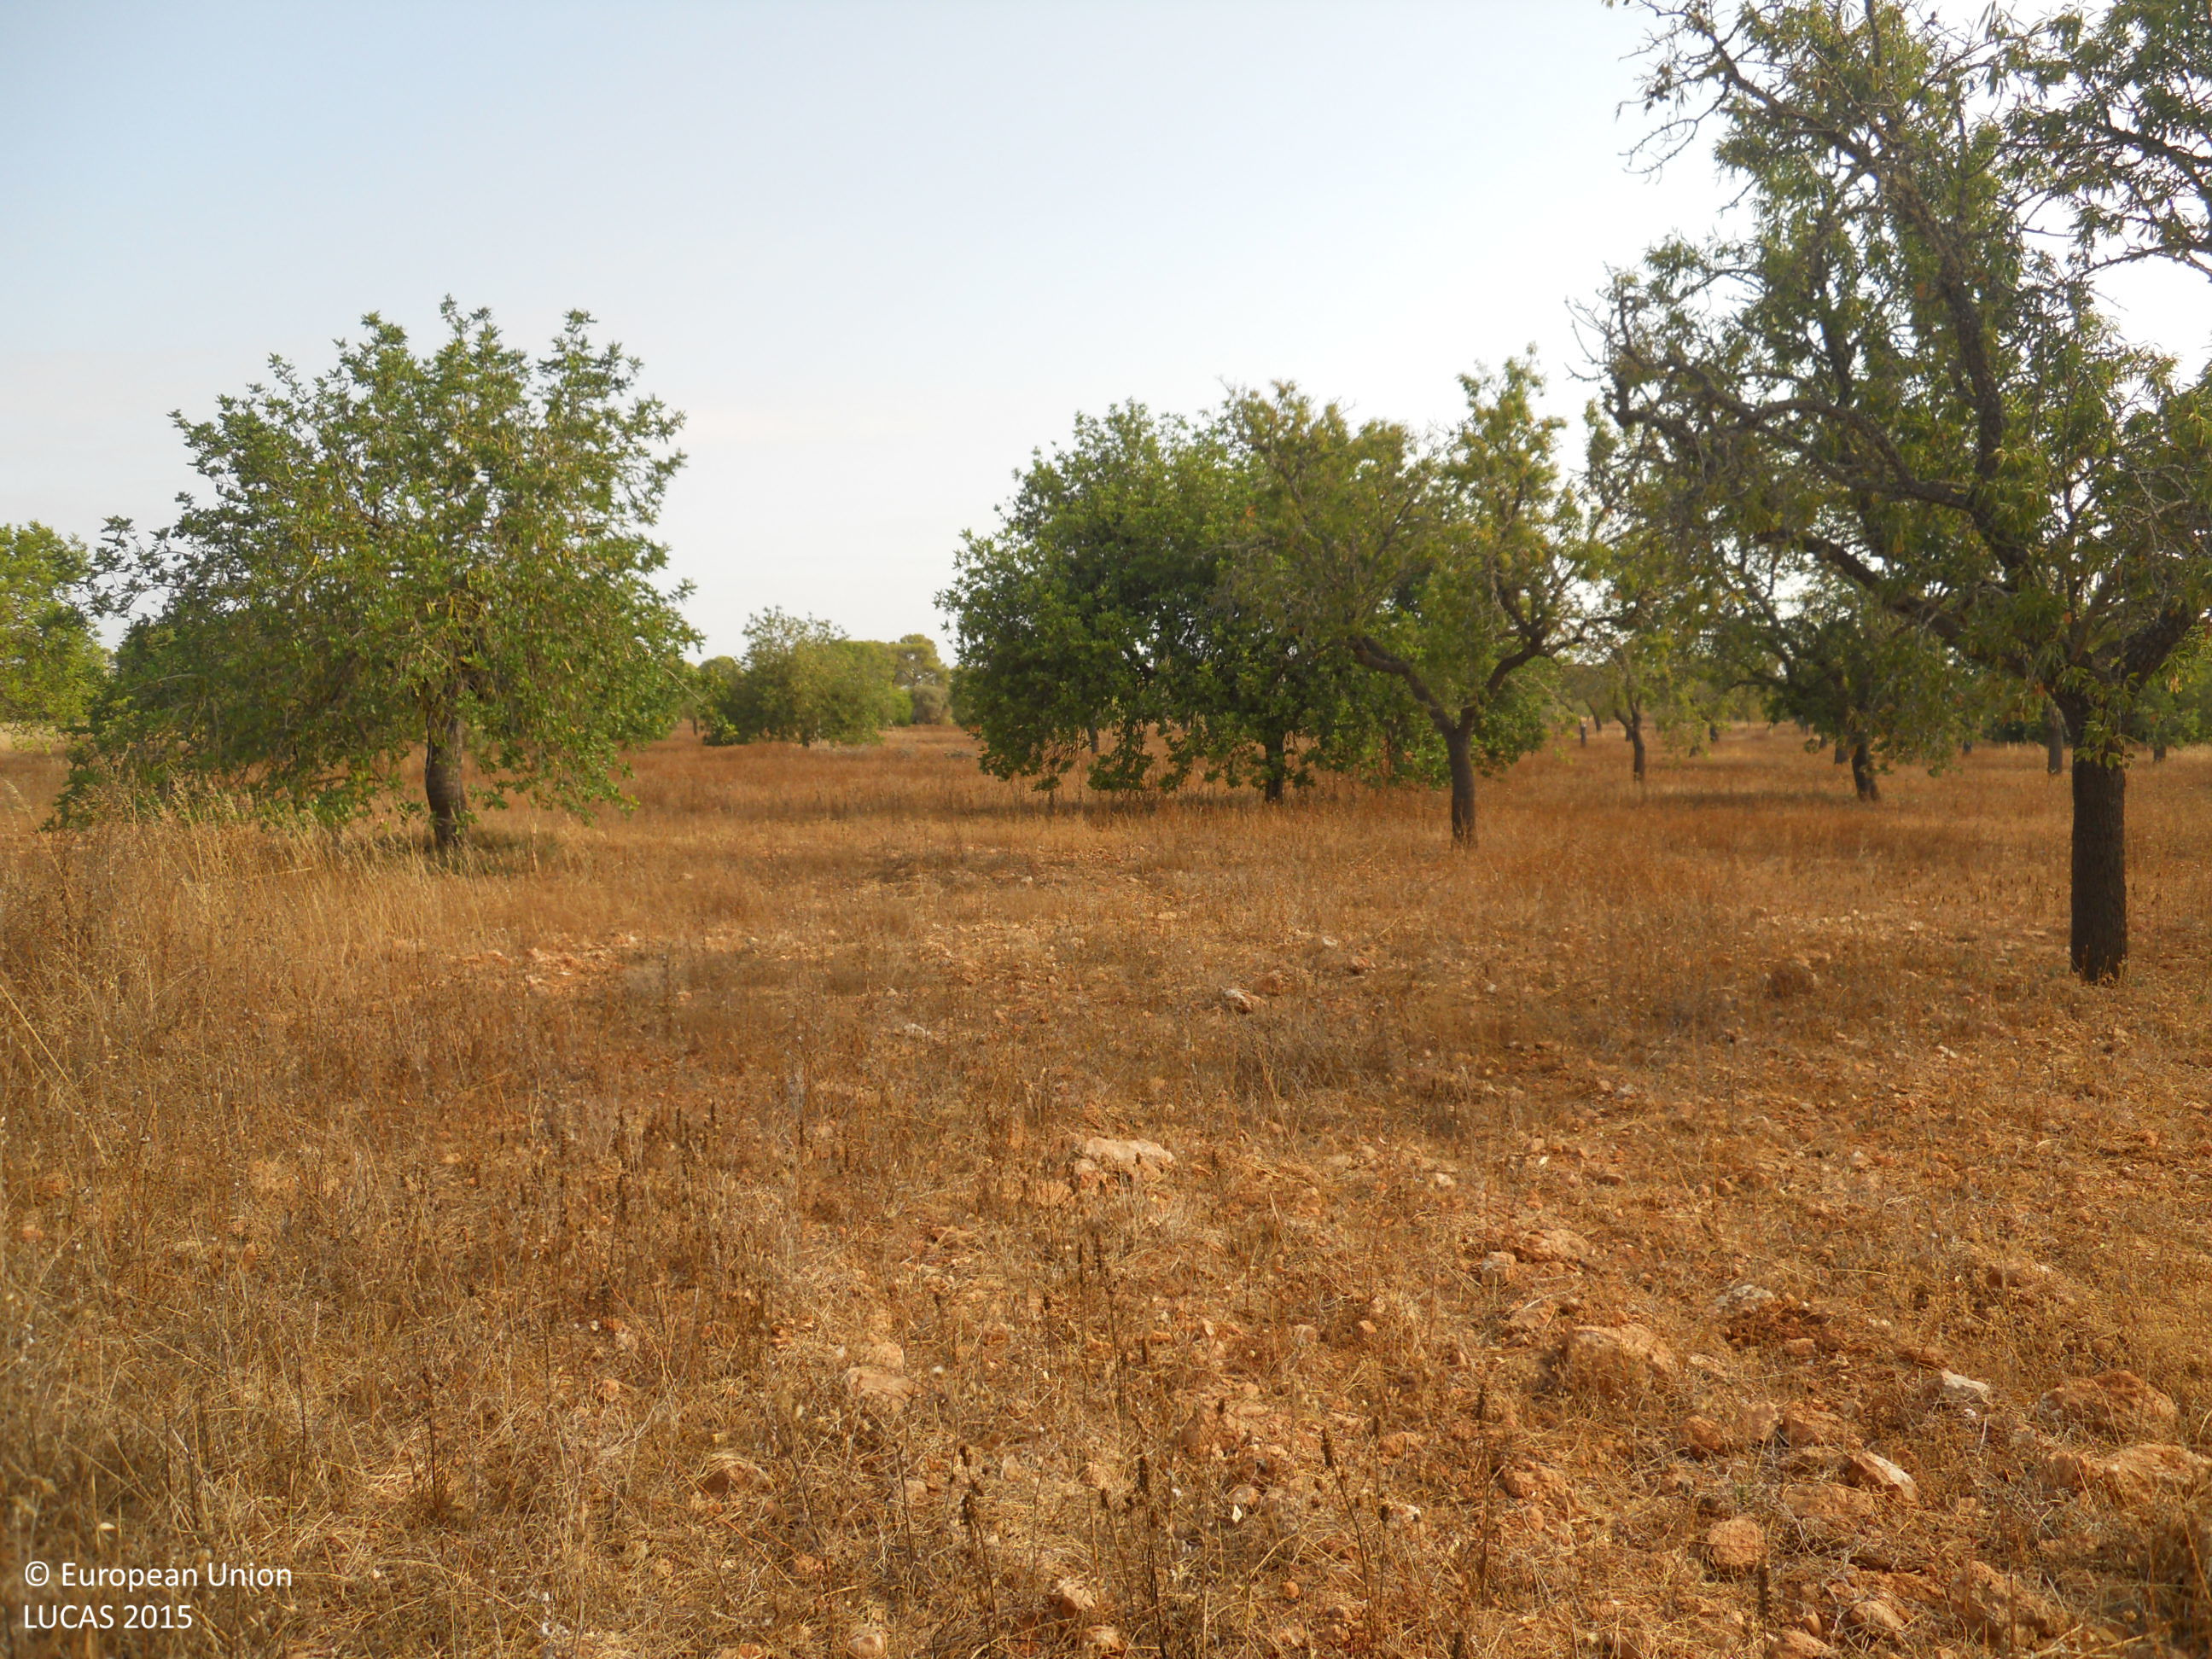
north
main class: Cropland
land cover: Nuts trees
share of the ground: 25 - 50 %
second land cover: Spontaneously vegetated surfaces
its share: 10 - 25 %
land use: Agriculture (excluding fallow land and kitchen gardens)
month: July
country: ES
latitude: 39.3931
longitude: 2.9139
